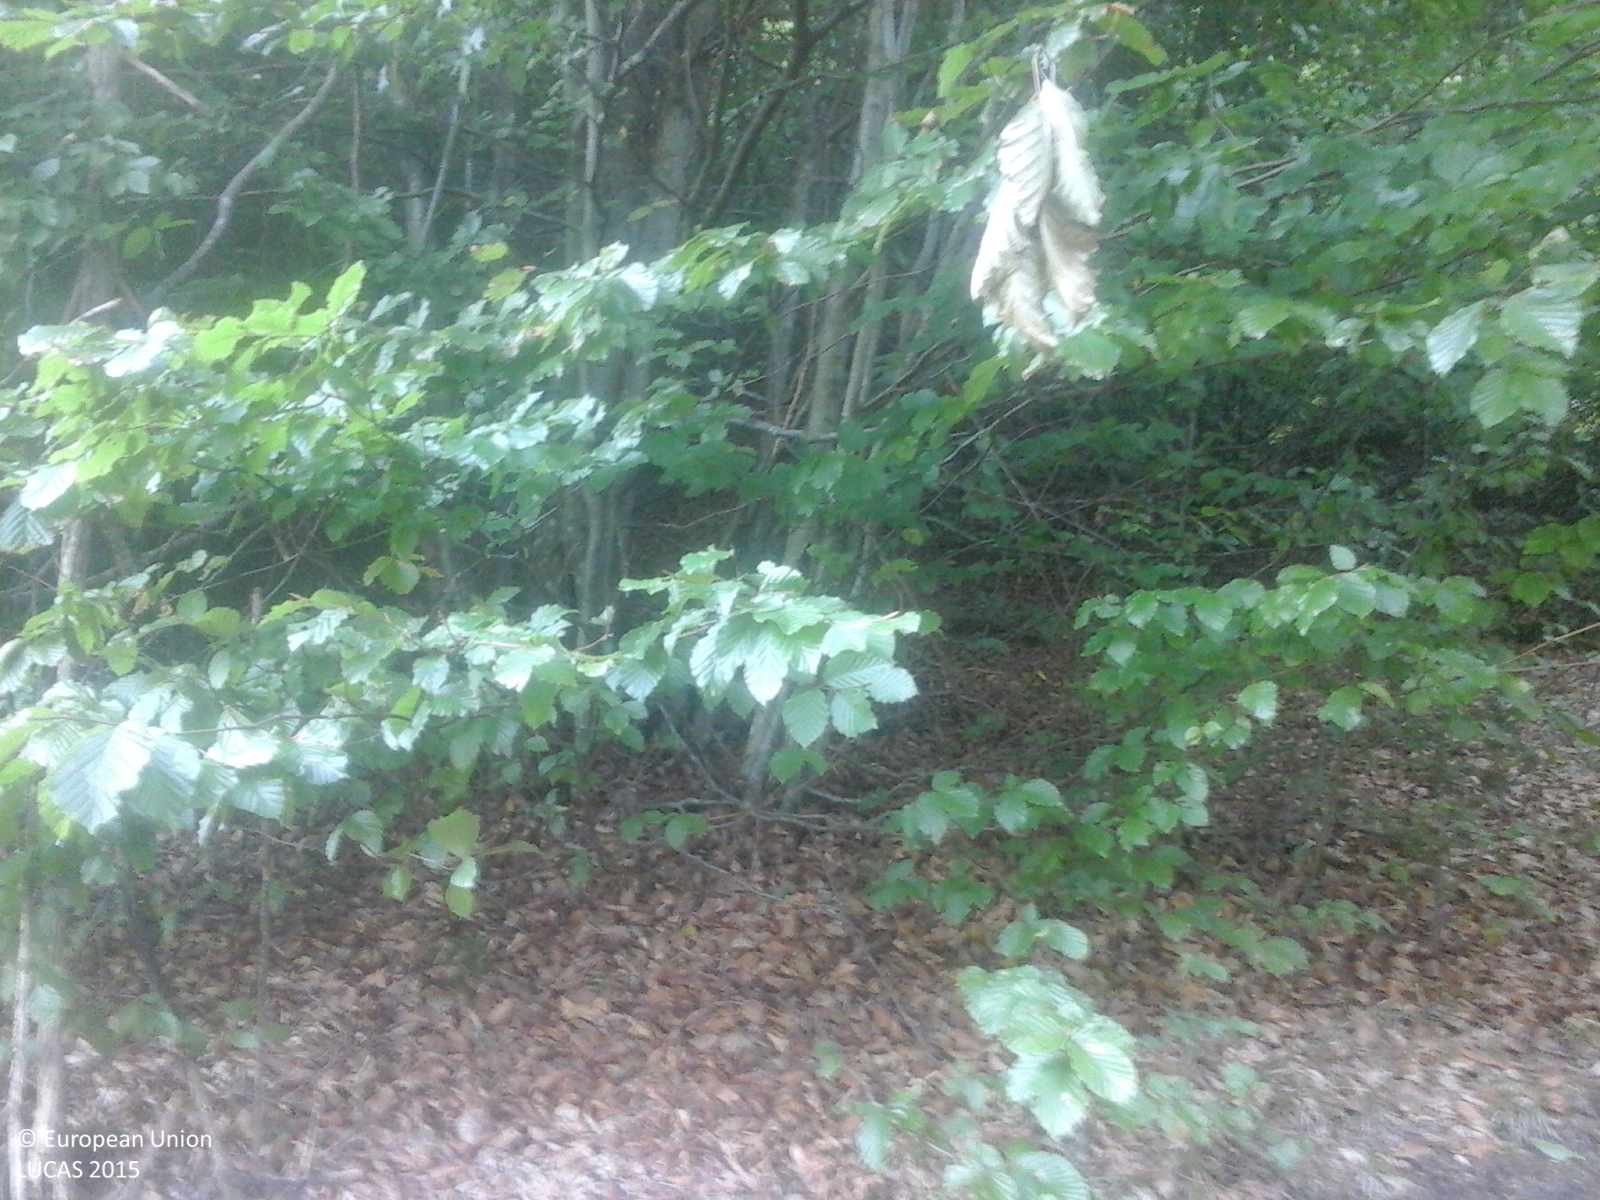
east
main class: Grassland
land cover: Grassland without tree/shrub cover
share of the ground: > 75 %
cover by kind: herbaceous plants 100 %
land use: Agriculture (excluding fallow land and kitchen gardens)
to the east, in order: Grassland without tree/shrub cover; Broadleaved woodland
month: September
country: RO
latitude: 46.8203
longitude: 22.6251
